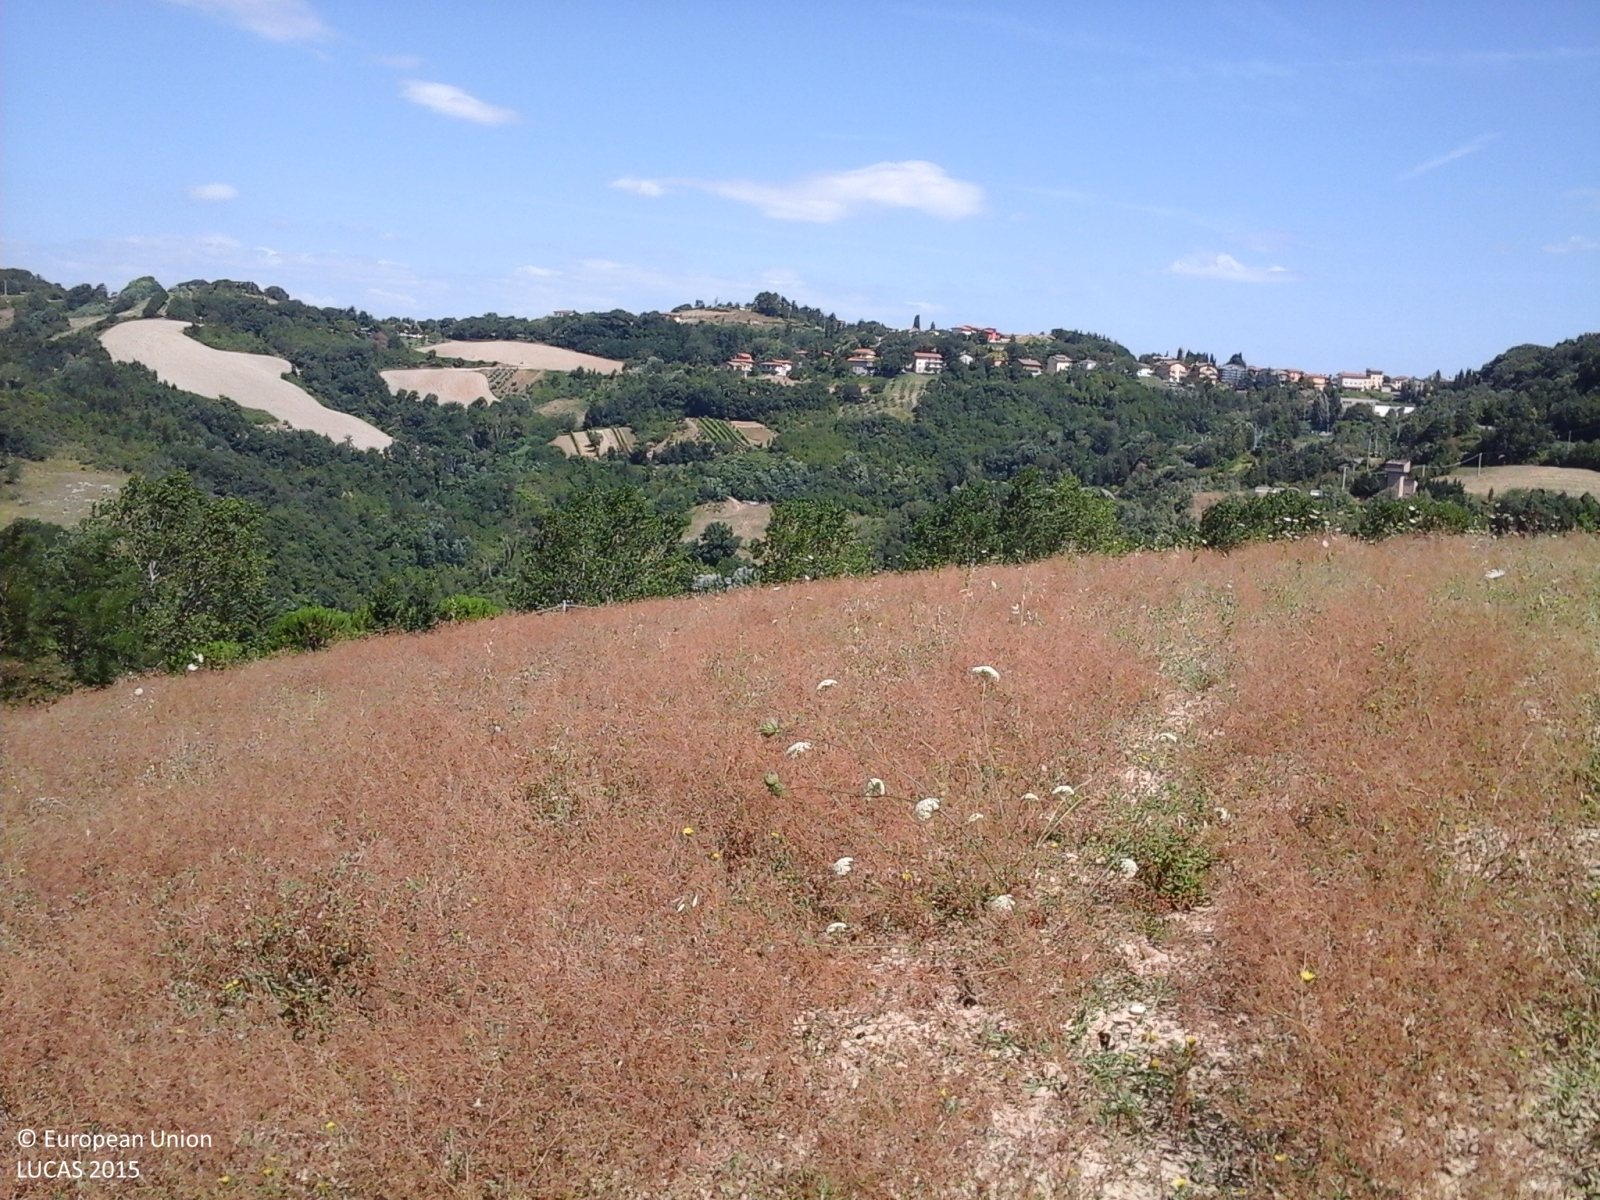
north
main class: Cropland
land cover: Other non-permanent industrial crops
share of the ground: > 75 %
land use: Agriculture (excluding fallow land and kitchen gardens)
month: July
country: IT
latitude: 43.8470
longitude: 12.6680
